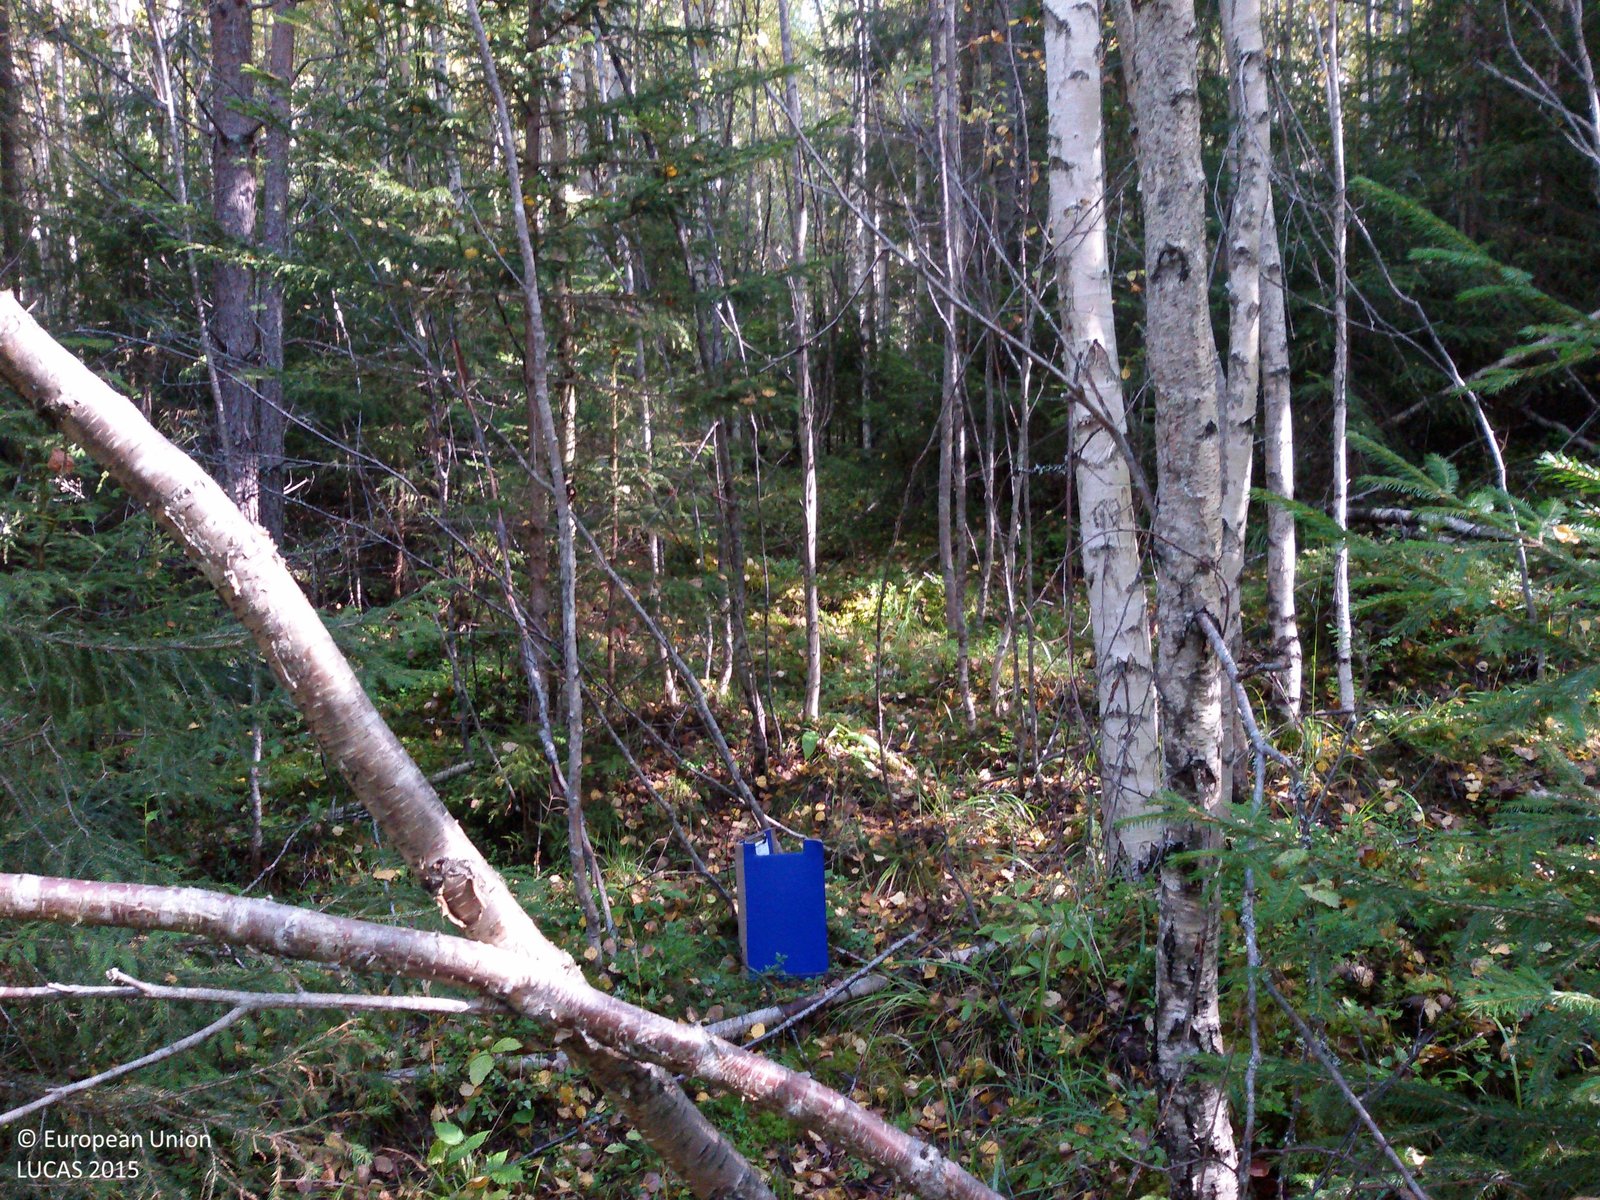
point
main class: Woodland
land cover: Spruce dominated mixed woodland
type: boreal forest
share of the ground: > 75 %
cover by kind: coniferous forest trees 45 %, broadleaved forest trees 45 %, herbaceous plants 5 %, lichens and mosses 5 %
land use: Forestry
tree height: > 5 m
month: September
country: SE
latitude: 60.7517
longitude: 14.7026
